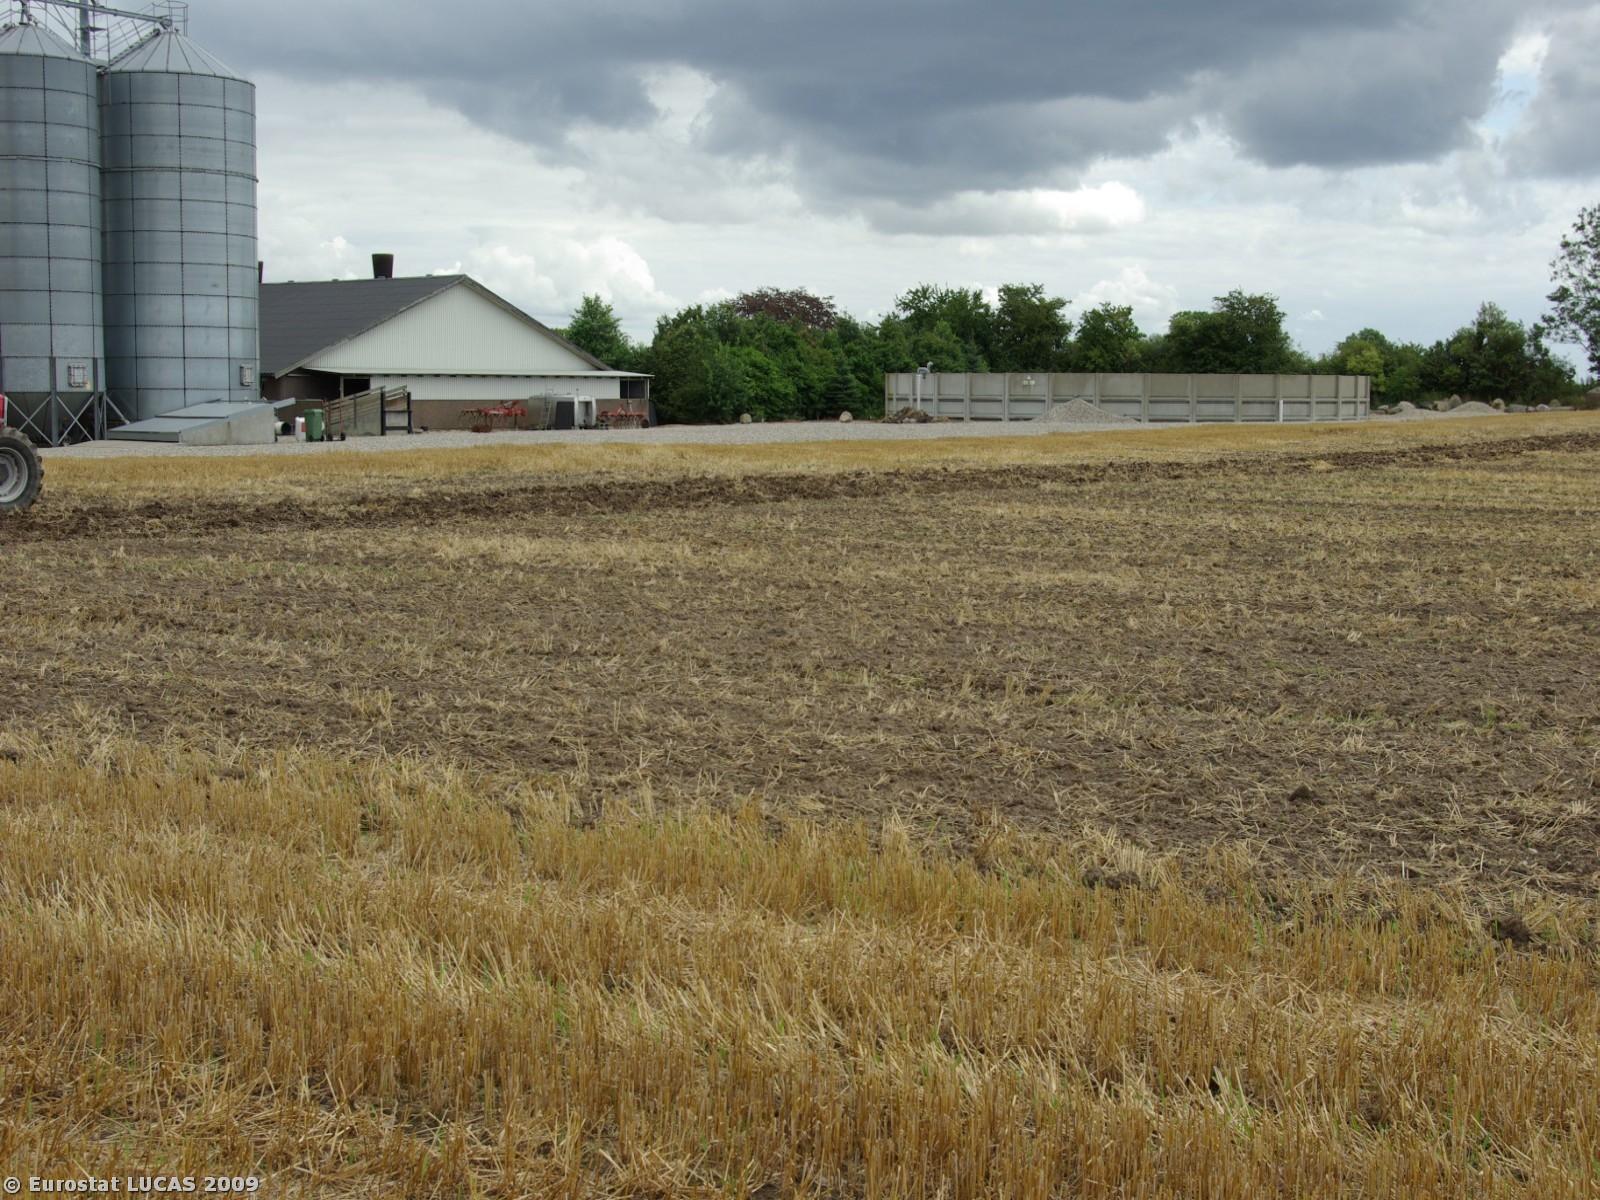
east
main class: Cropland
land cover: Common wheat
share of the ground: > 75 %
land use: Agriculture (excluding fallow land and kitchen gardens)
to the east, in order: Common wheat; Barley; Artificial constructions in urban areas; Broadleaved woodland
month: July
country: DK
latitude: 55.2526
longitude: 9.6699
